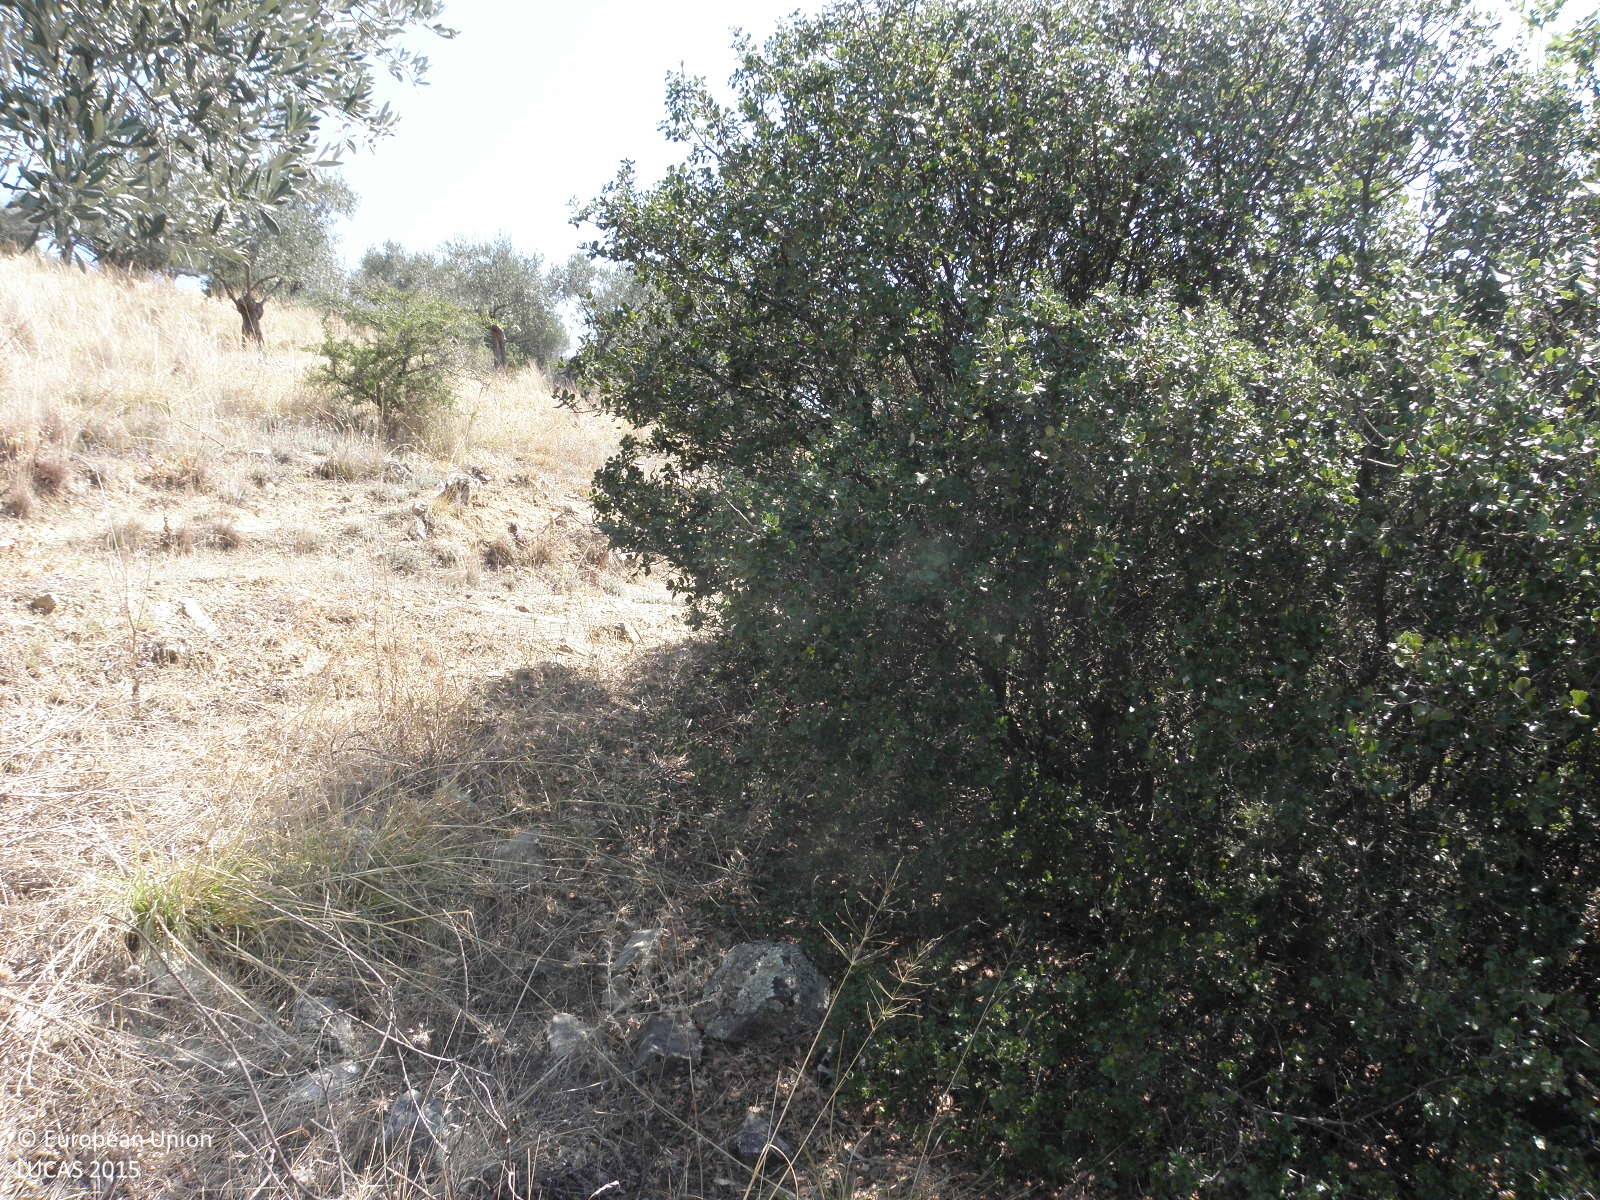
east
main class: Cropland
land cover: Olive groves
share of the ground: 25 - 50 %
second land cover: Spontaneously vegetated surfaces
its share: > 75 %
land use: Agriculture (excluding fallow land and kitchen gardens)
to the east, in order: Olive groves; Spontaneously vegetated surfaces; Tracks; Olive groves
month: August
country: GR
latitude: 39.8382
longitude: 22.4377
